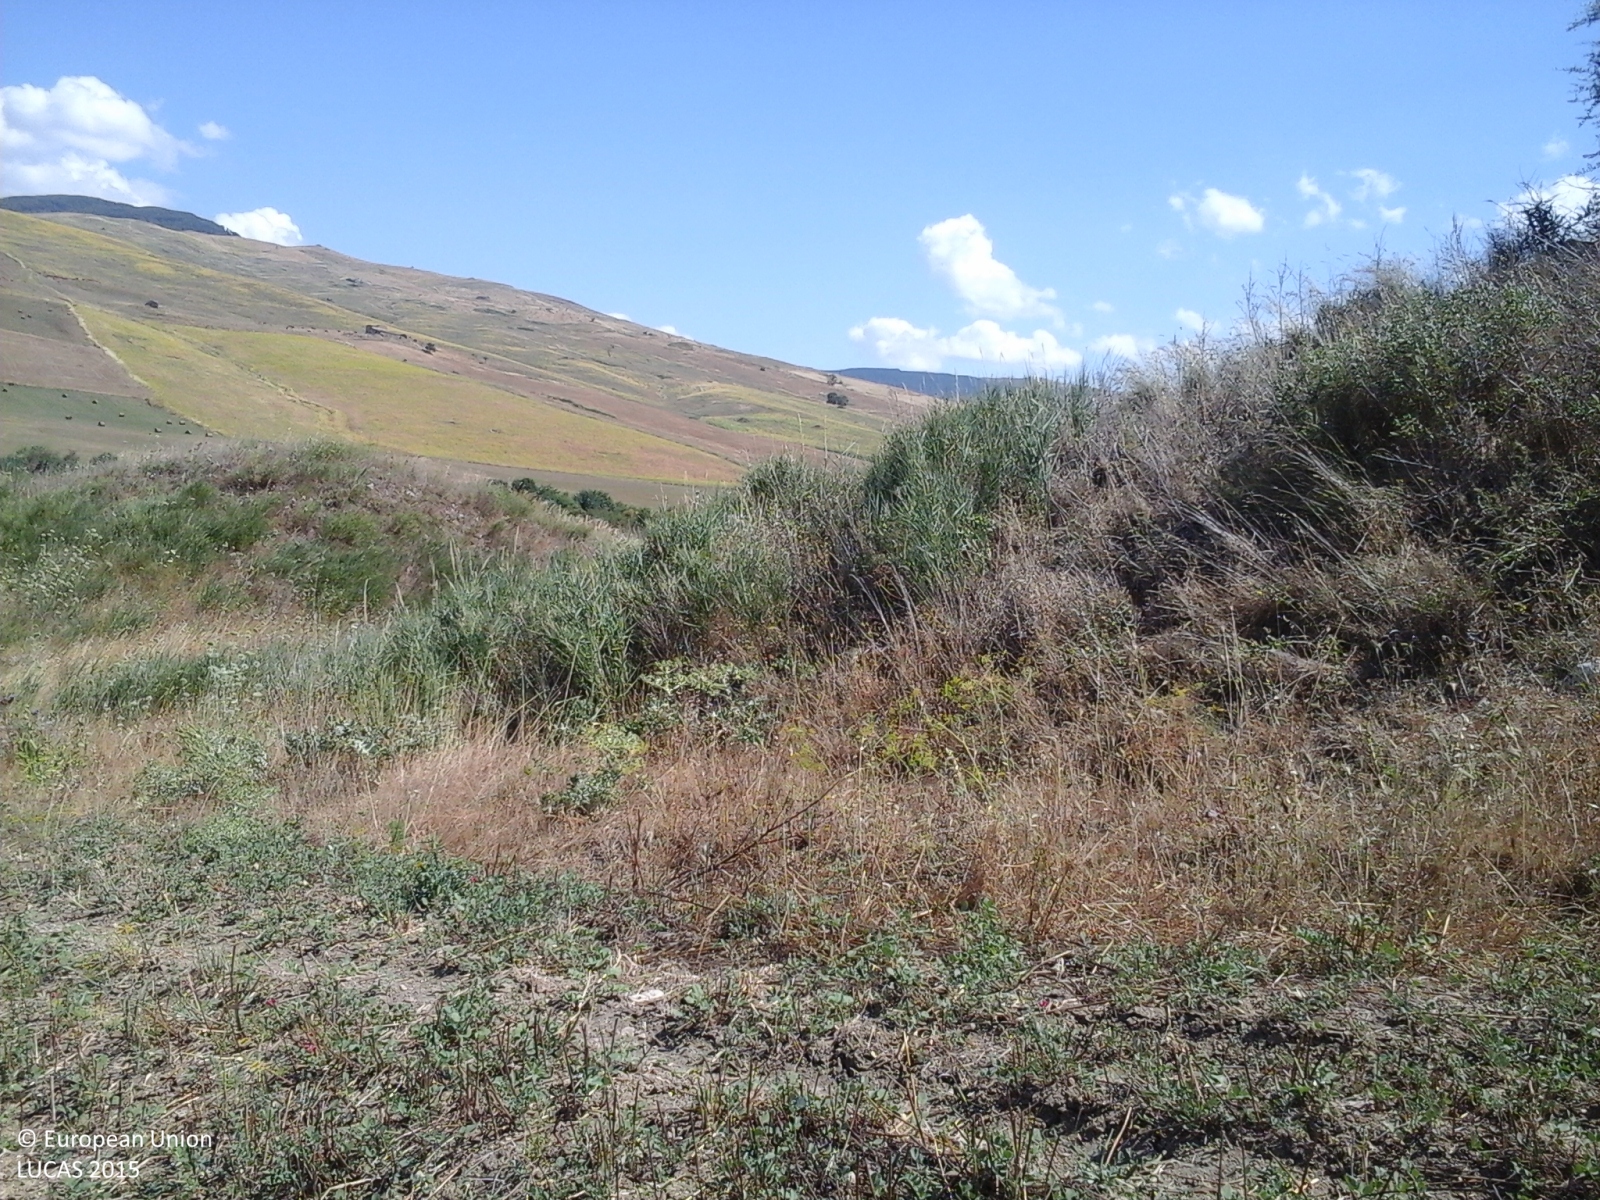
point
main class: Grassland
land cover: Grassland with sparse tree/shrub cover
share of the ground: > 75 %
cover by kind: herbaceous plants 85 %, shrubs 10 %, broadleaved forest trees 5 %
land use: Agriculture (excluding fallow land and kitchen gardens)
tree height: < 5 m
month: June
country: IT
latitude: 37.7911
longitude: 13.5286
